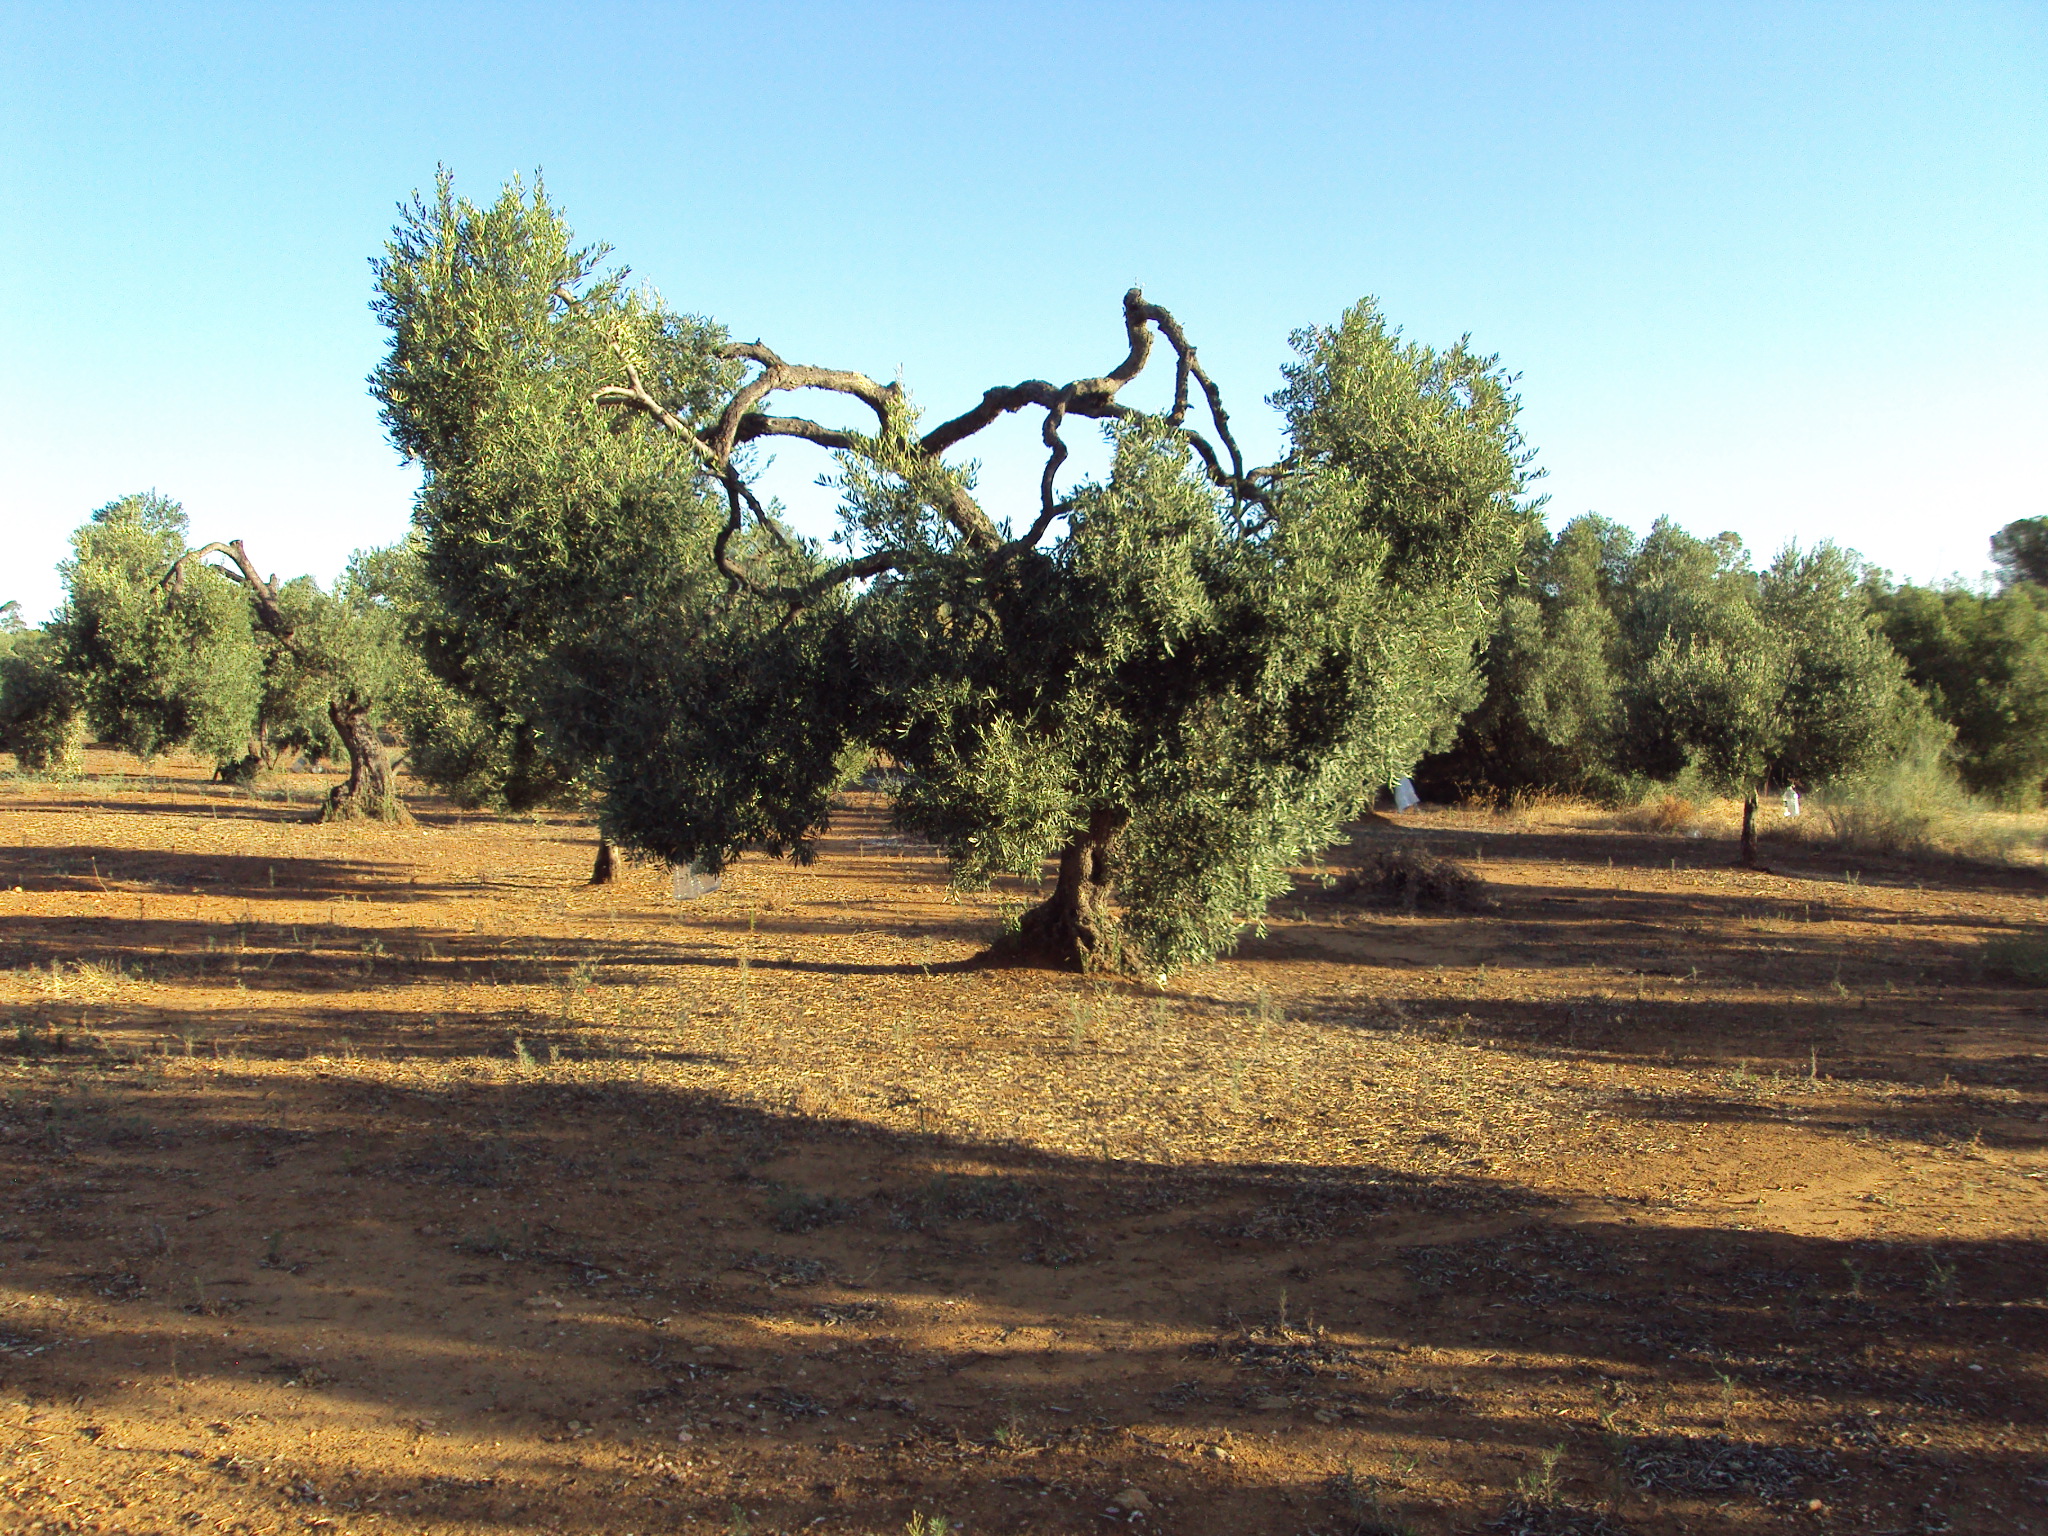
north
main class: Cropland
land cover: Olive groves
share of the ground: 25 - 50 %
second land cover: Other bare soil
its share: > 75 %
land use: Agriculture (excluding fallow land and kitchen gardens)
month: July
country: ES
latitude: 37.4057
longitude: -6.9995
